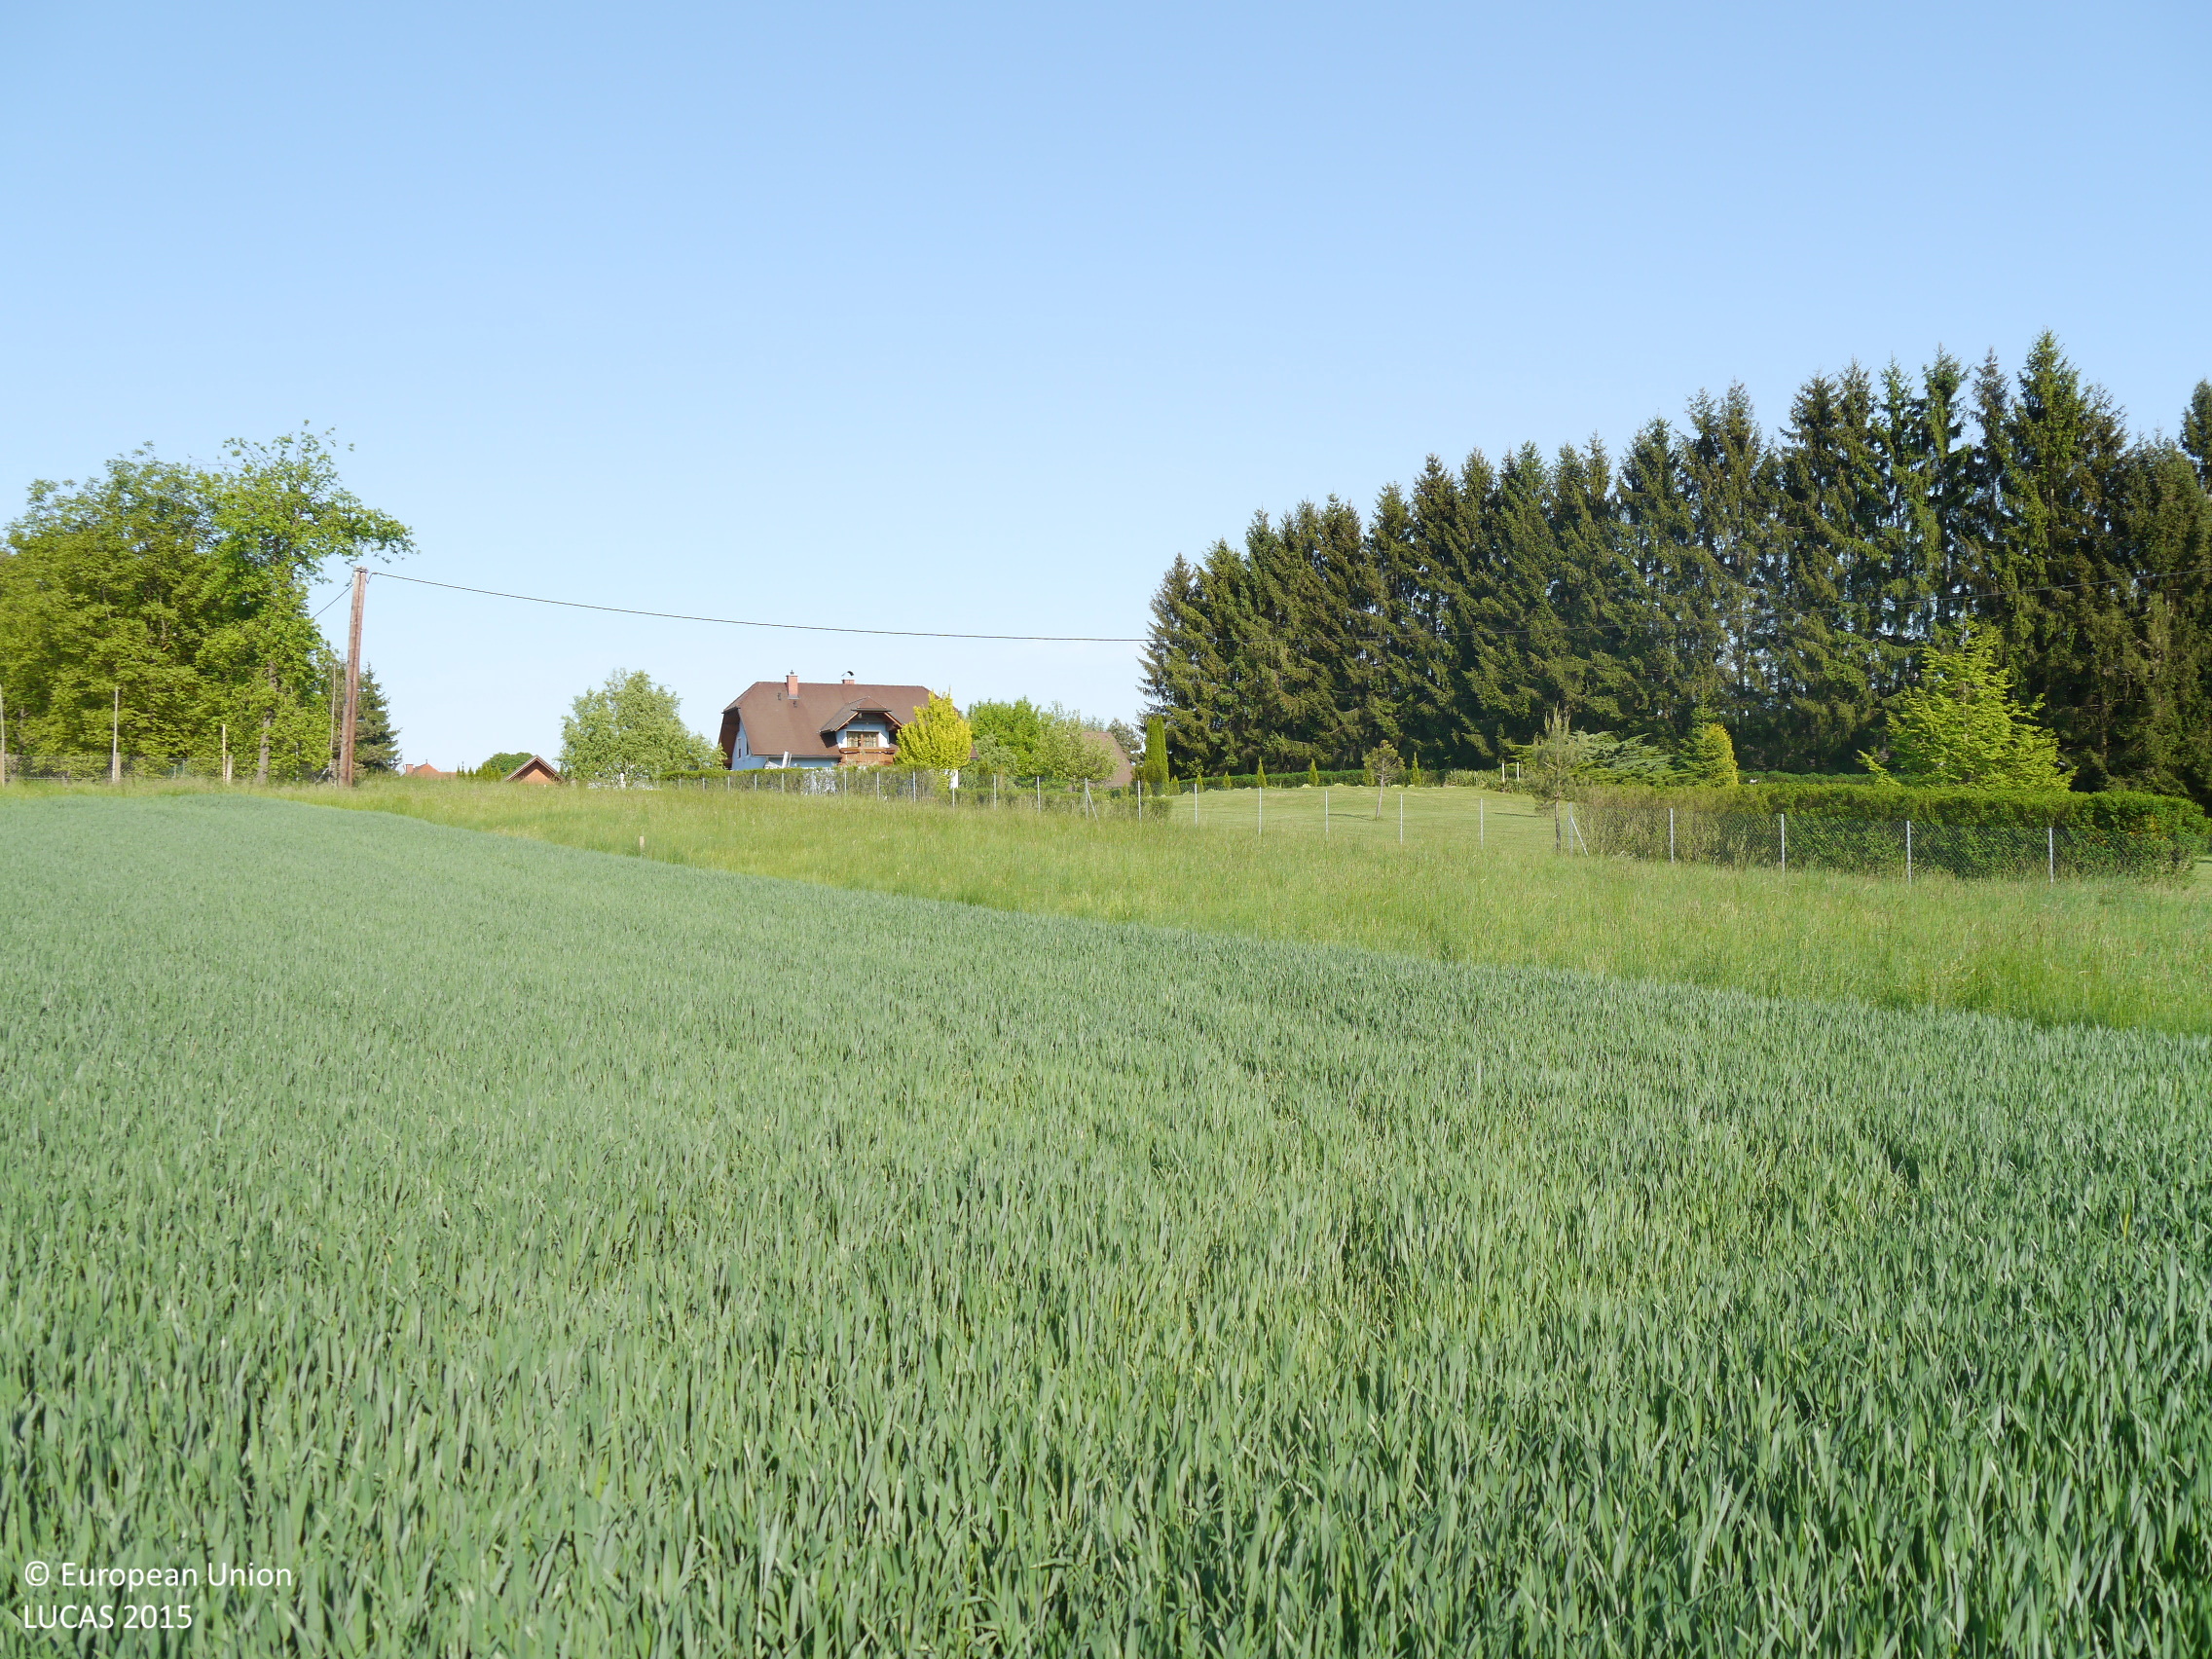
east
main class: Cropland
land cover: Common wheat
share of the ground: > 75 %
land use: Agriculture (excluding fallow land and kitchen gardens)
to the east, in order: Common wheat; Grassland without tree/shrub cover; Electric lines; Grassland without tree/shrub cover; Artificial constructions in urban areas; Grassland without tree/shrub cover; Artificial constructions in urban areas
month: May
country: AT
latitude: 46.9548
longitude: 15.4001
